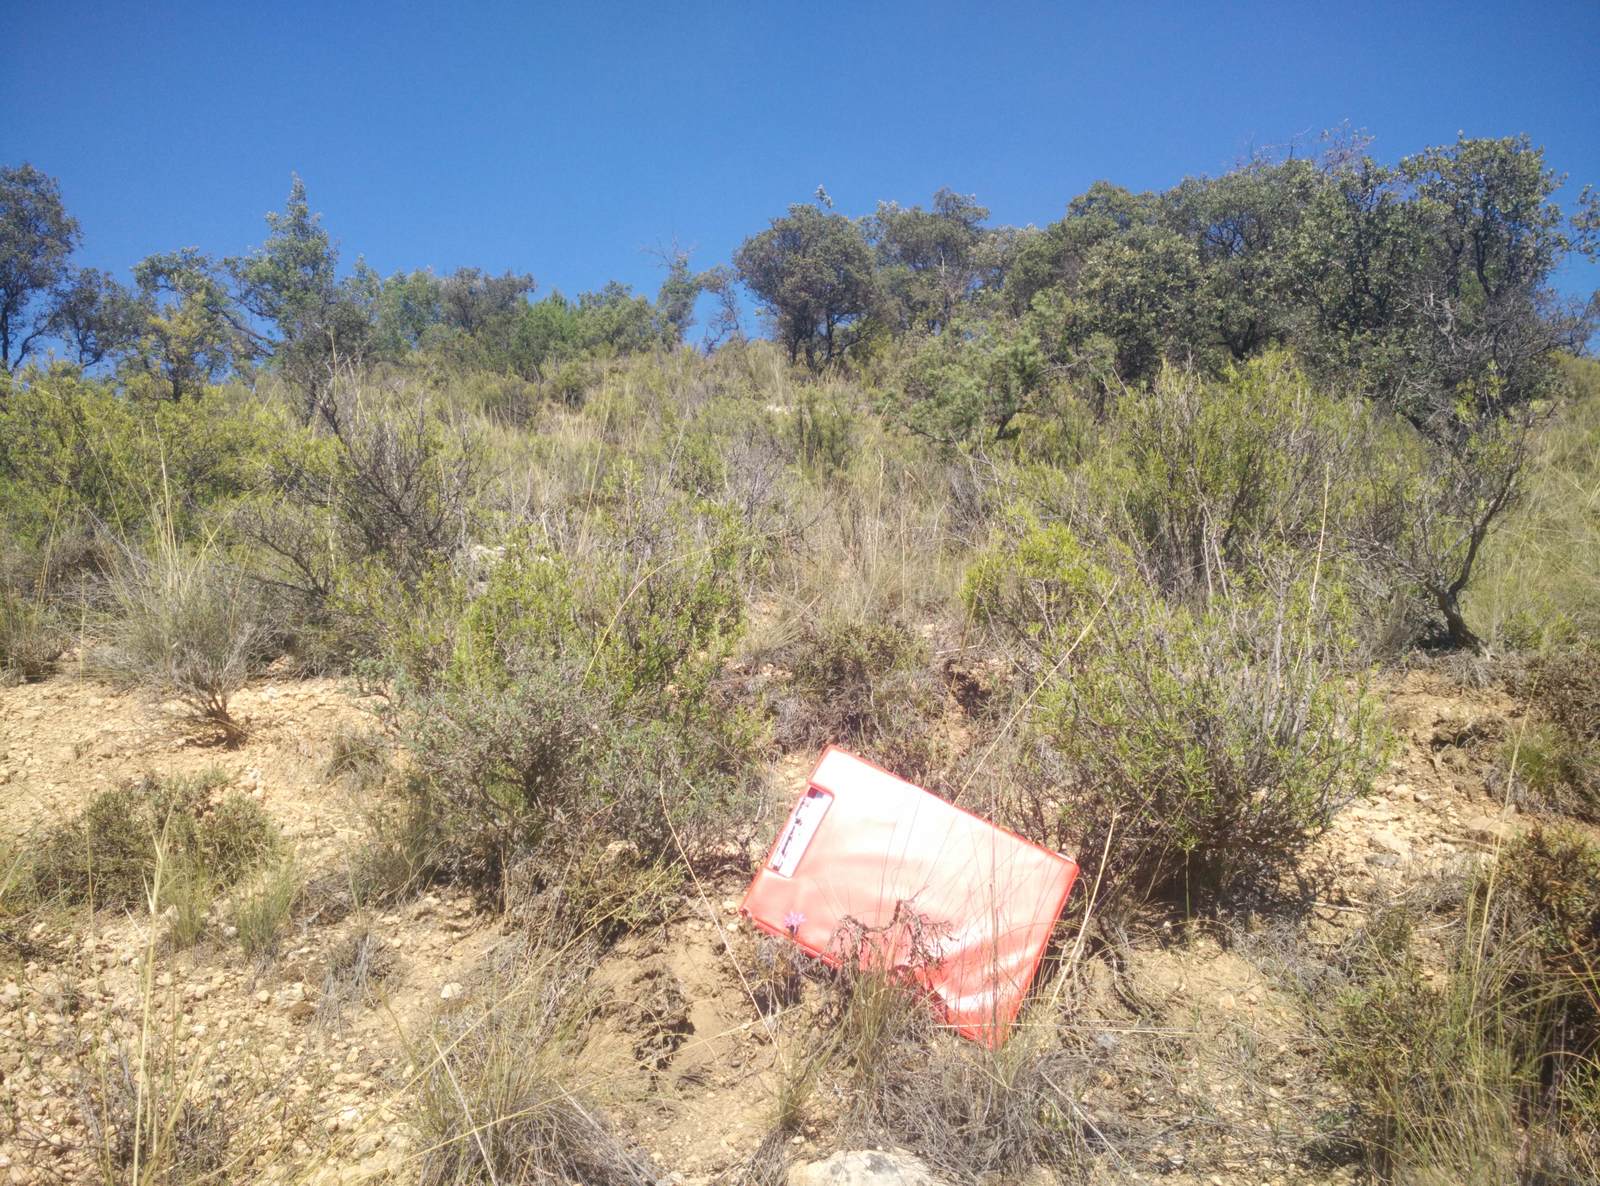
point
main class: Shrubland
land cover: Shrubland with sparse tree cover
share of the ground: > 75 %
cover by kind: shrubs 70 %, unconsolidated bare surface 15 %, herbaceous plants 10 %, broadleaved forest trees 5 %
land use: Semi-natural and natural areas not in use
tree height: > 5 m
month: July
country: ES
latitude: 40.7204
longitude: -2.6843
